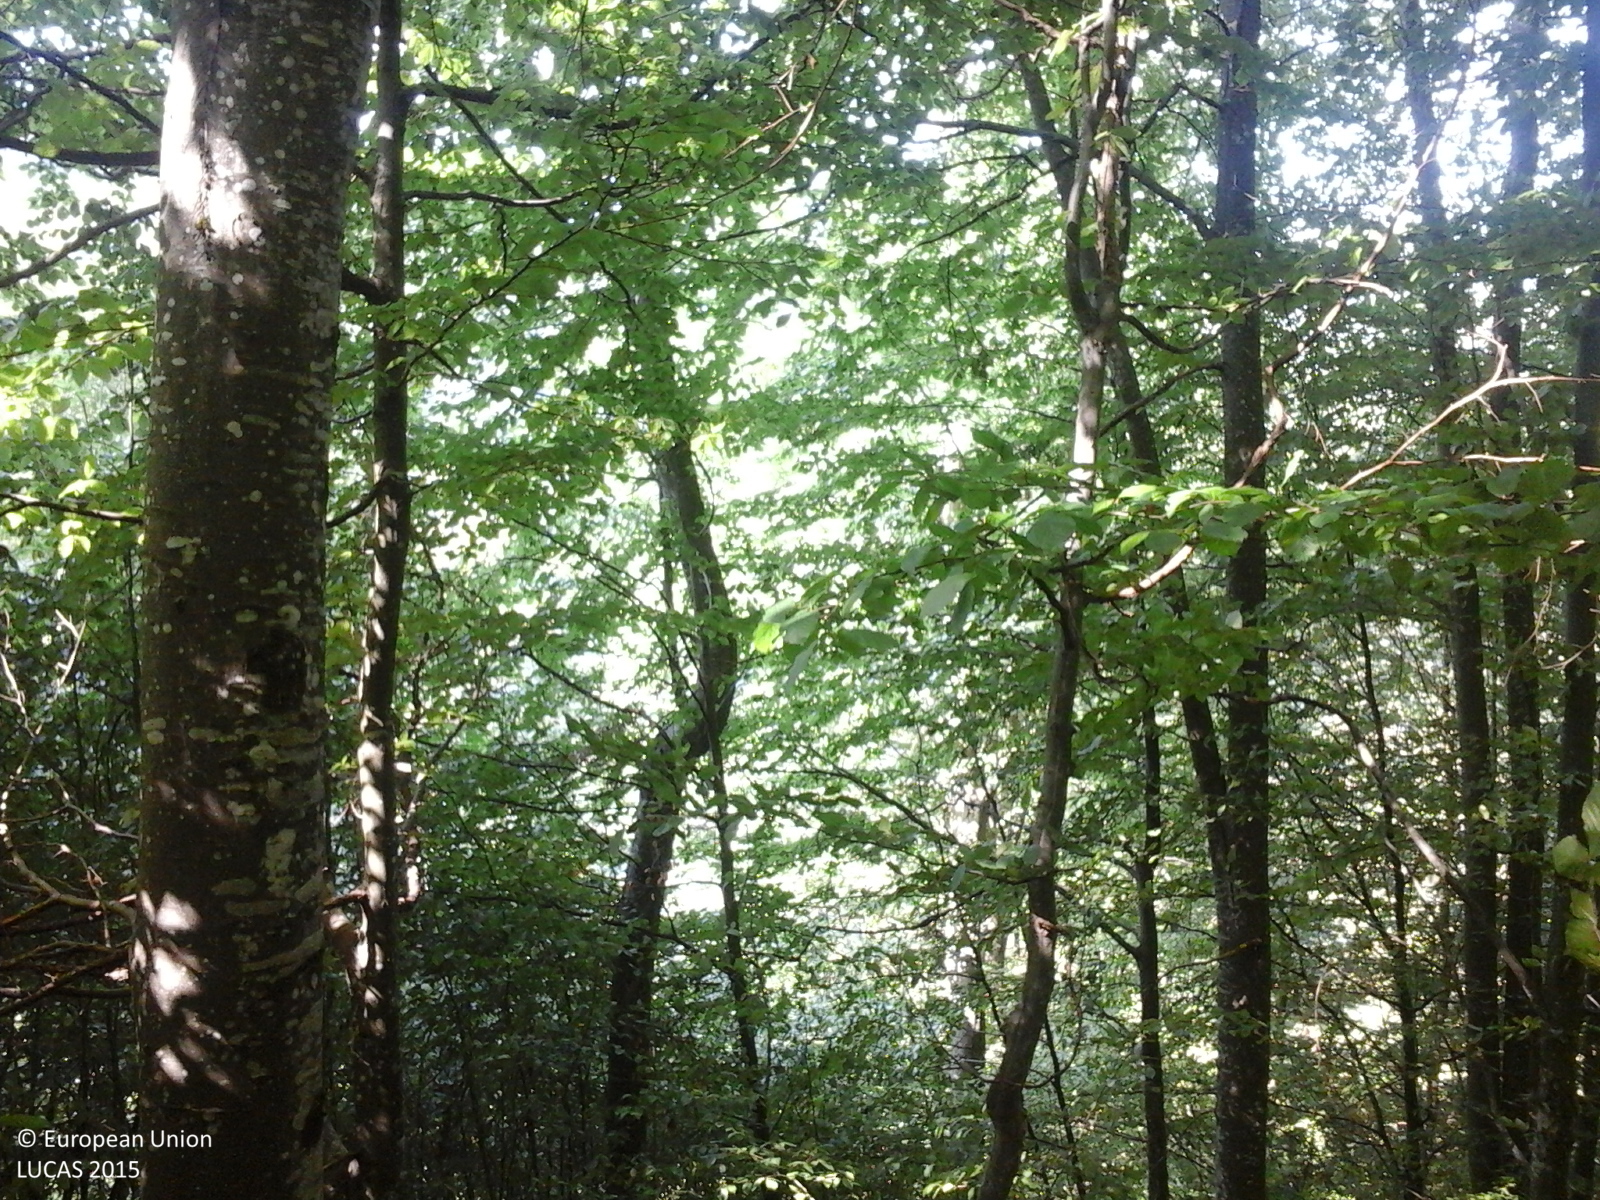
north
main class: Woodland
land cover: Broadleaved woodland
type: beech forest
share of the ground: > 75 %
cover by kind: broadleaved forest trees 100 %
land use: Forestry
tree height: > 5 m
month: September
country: RO
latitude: 47.8201
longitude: 24.2615
